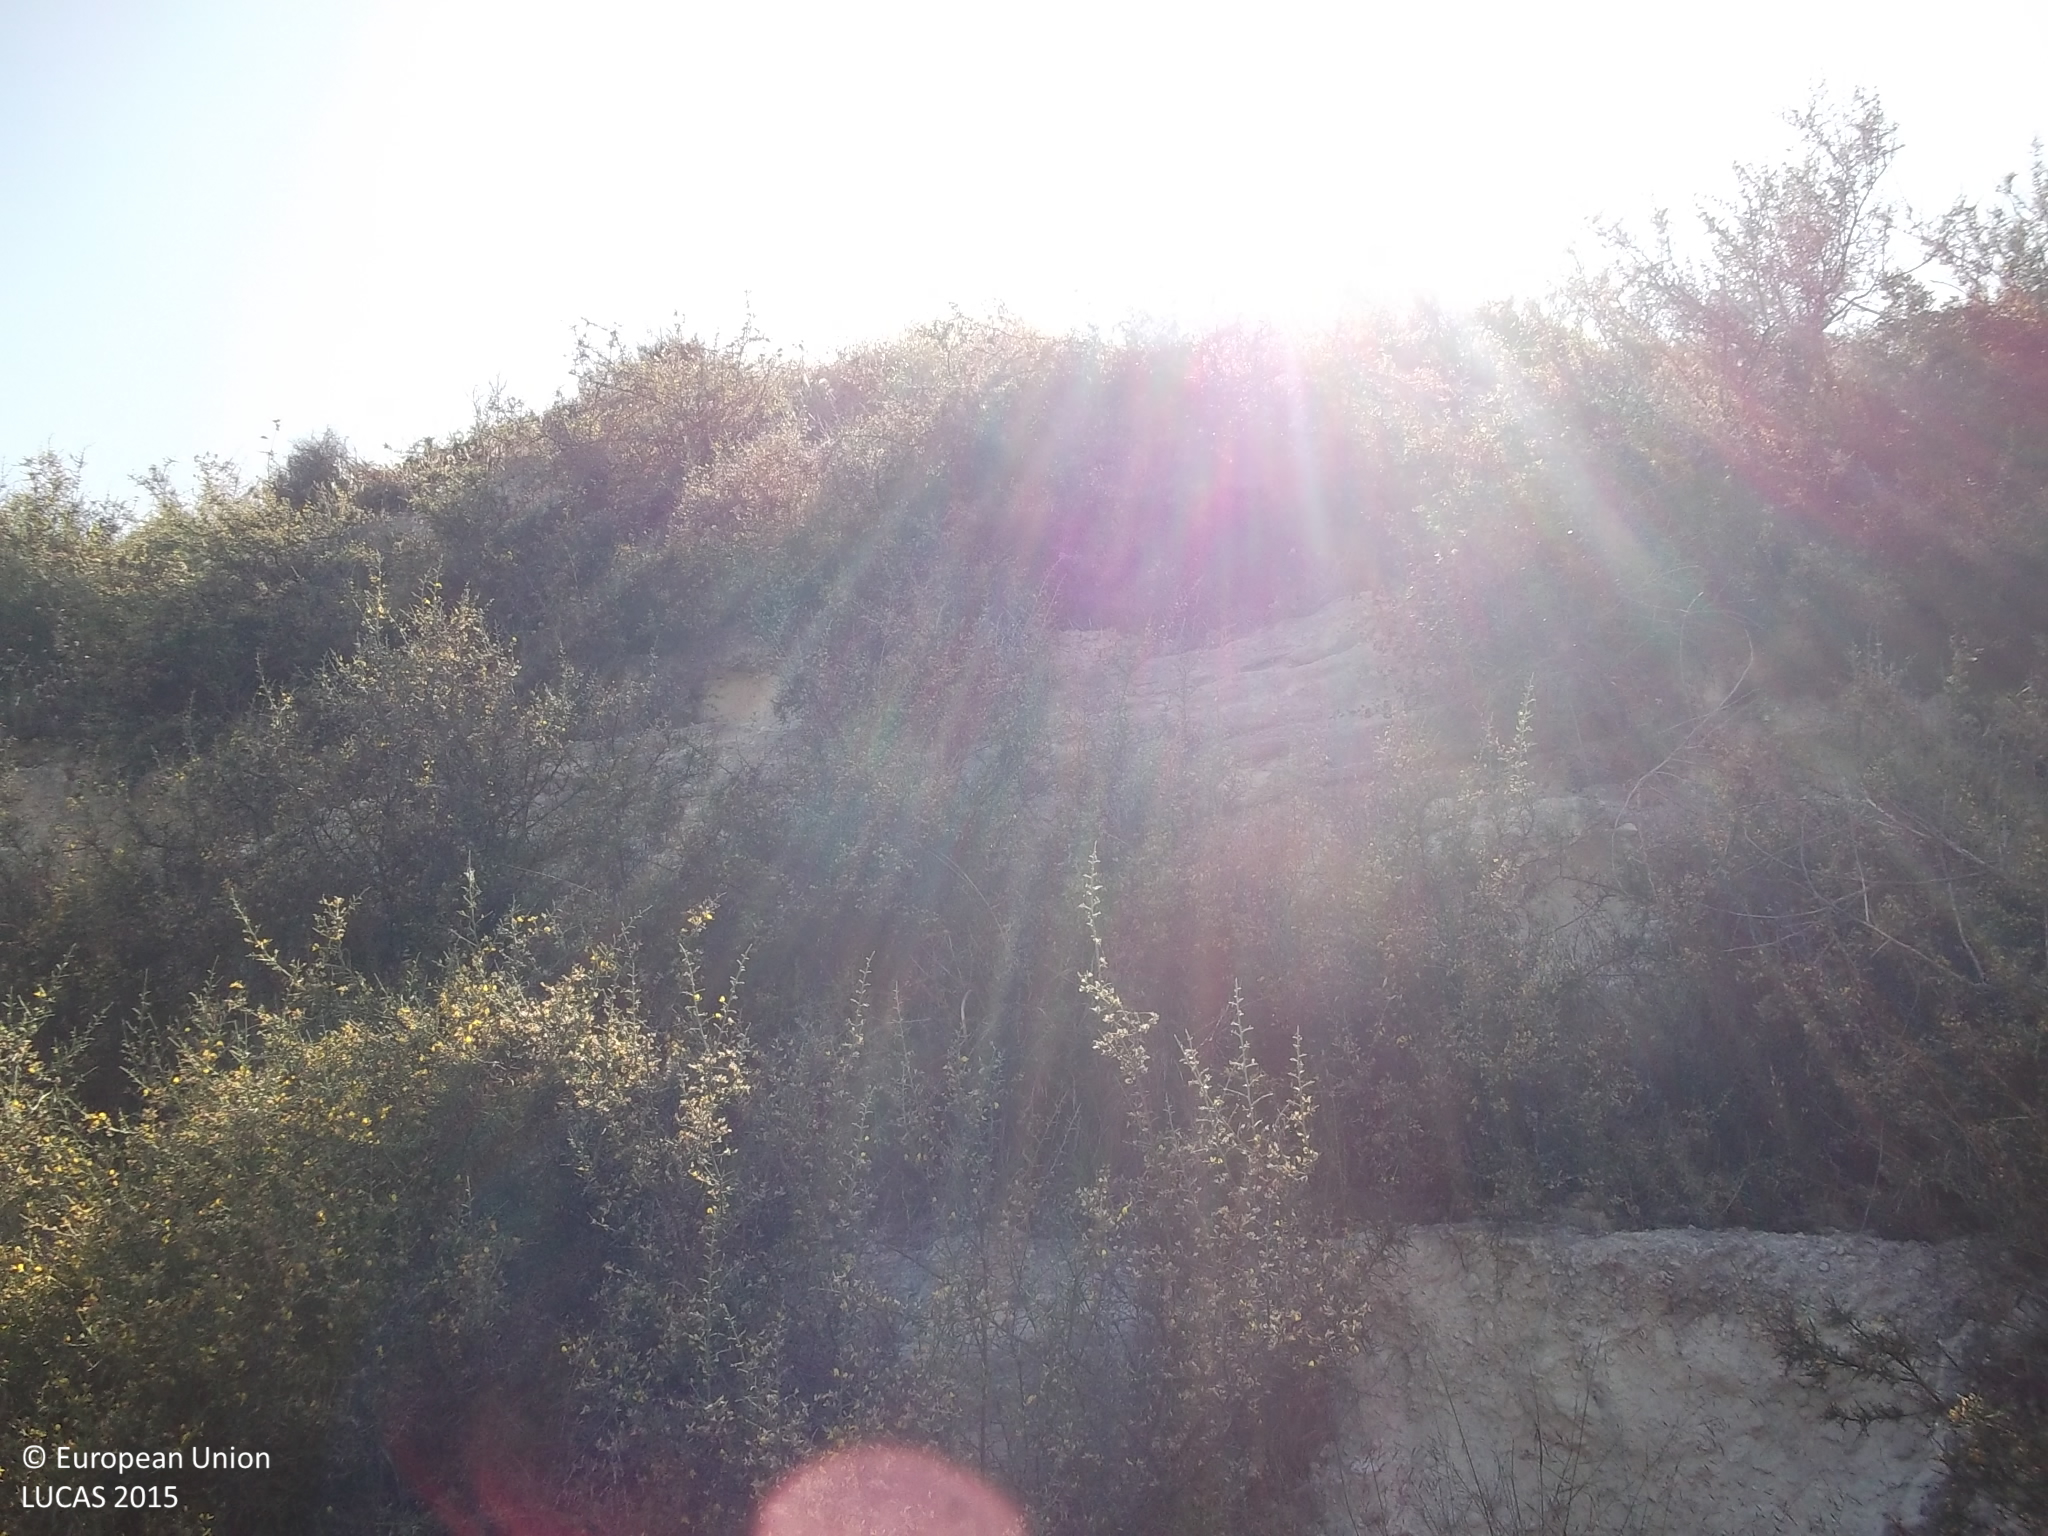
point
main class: Shrubland
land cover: Shrubland without tree cover
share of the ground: 50 - 75 %
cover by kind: shrubs 75 %, herbaceous plants 15 %, unconsolidated bare surface 10 %
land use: Semi-natural and natural areas not in use
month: May
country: CY
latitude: 34.7167
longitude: 32.5652
